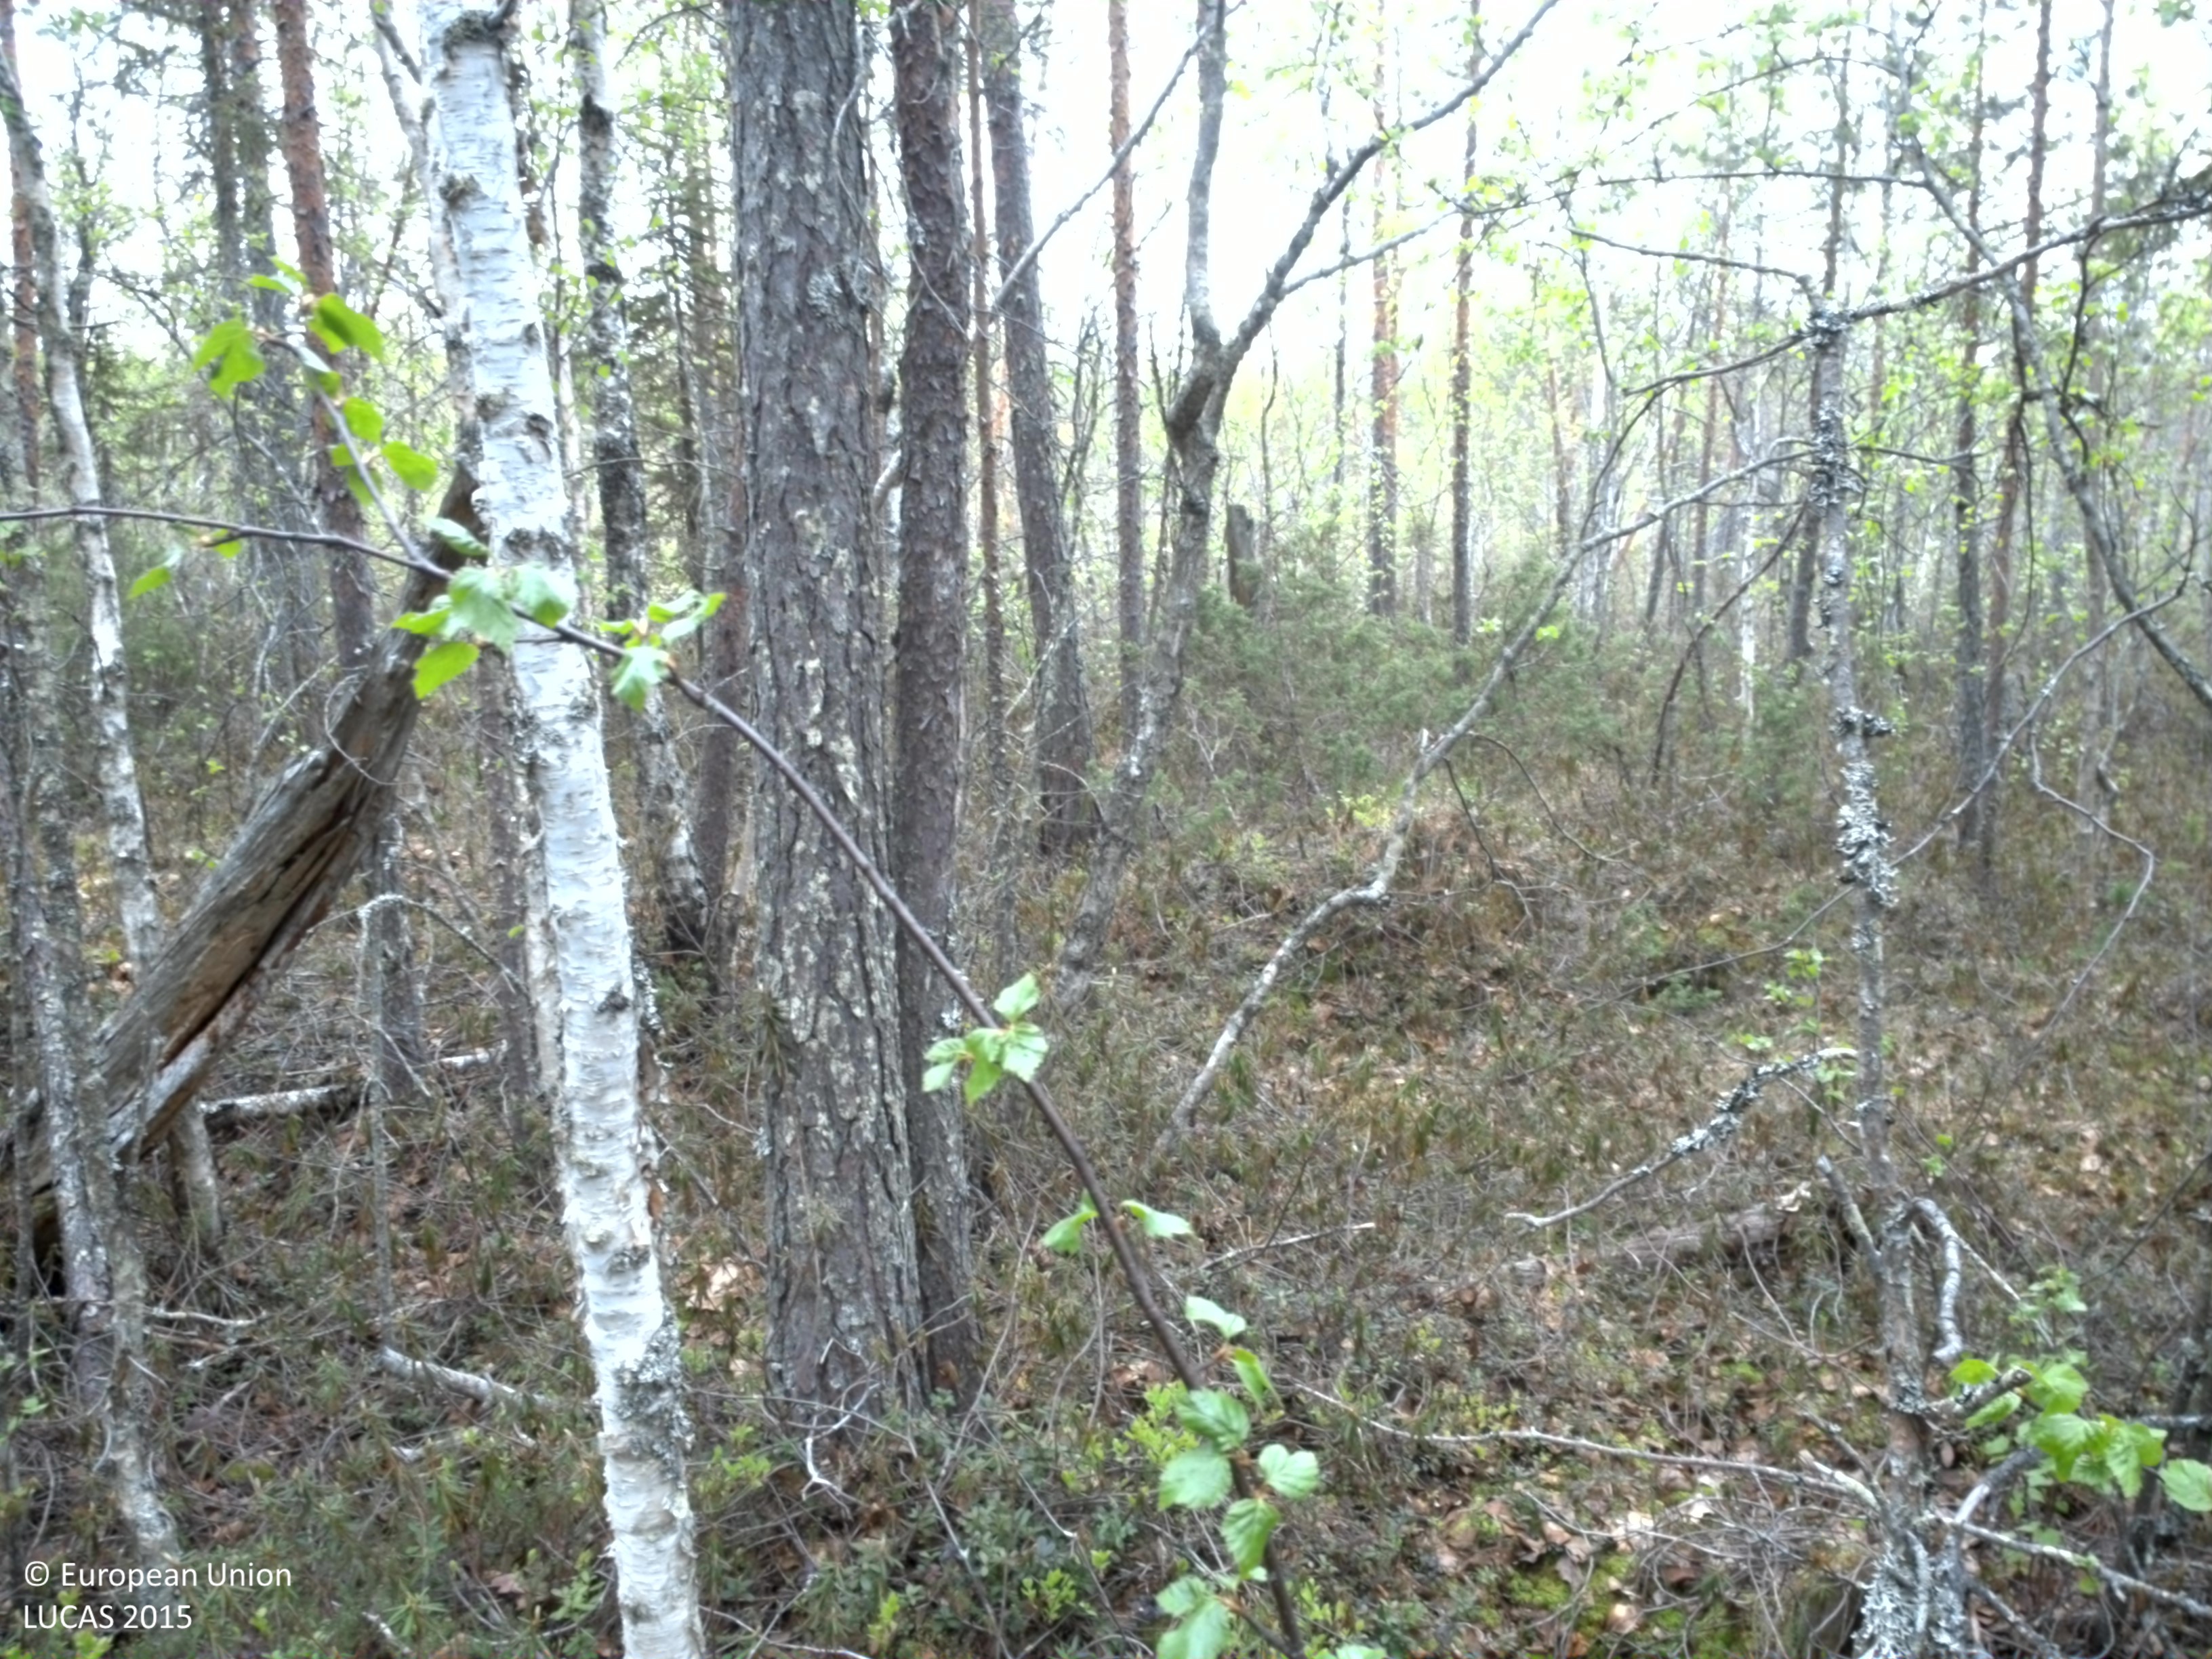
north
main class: Woodland
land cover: Pine dominated mixed woodland
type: boreal forest
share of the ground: > 75 %
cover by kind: coniferous forest trees 45 %, broadleaved forest trees 40 %, shrubs 15 %
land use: Forestry
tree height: > 5 m
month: June
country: SE
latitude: 66.3694
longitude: 22.8778
